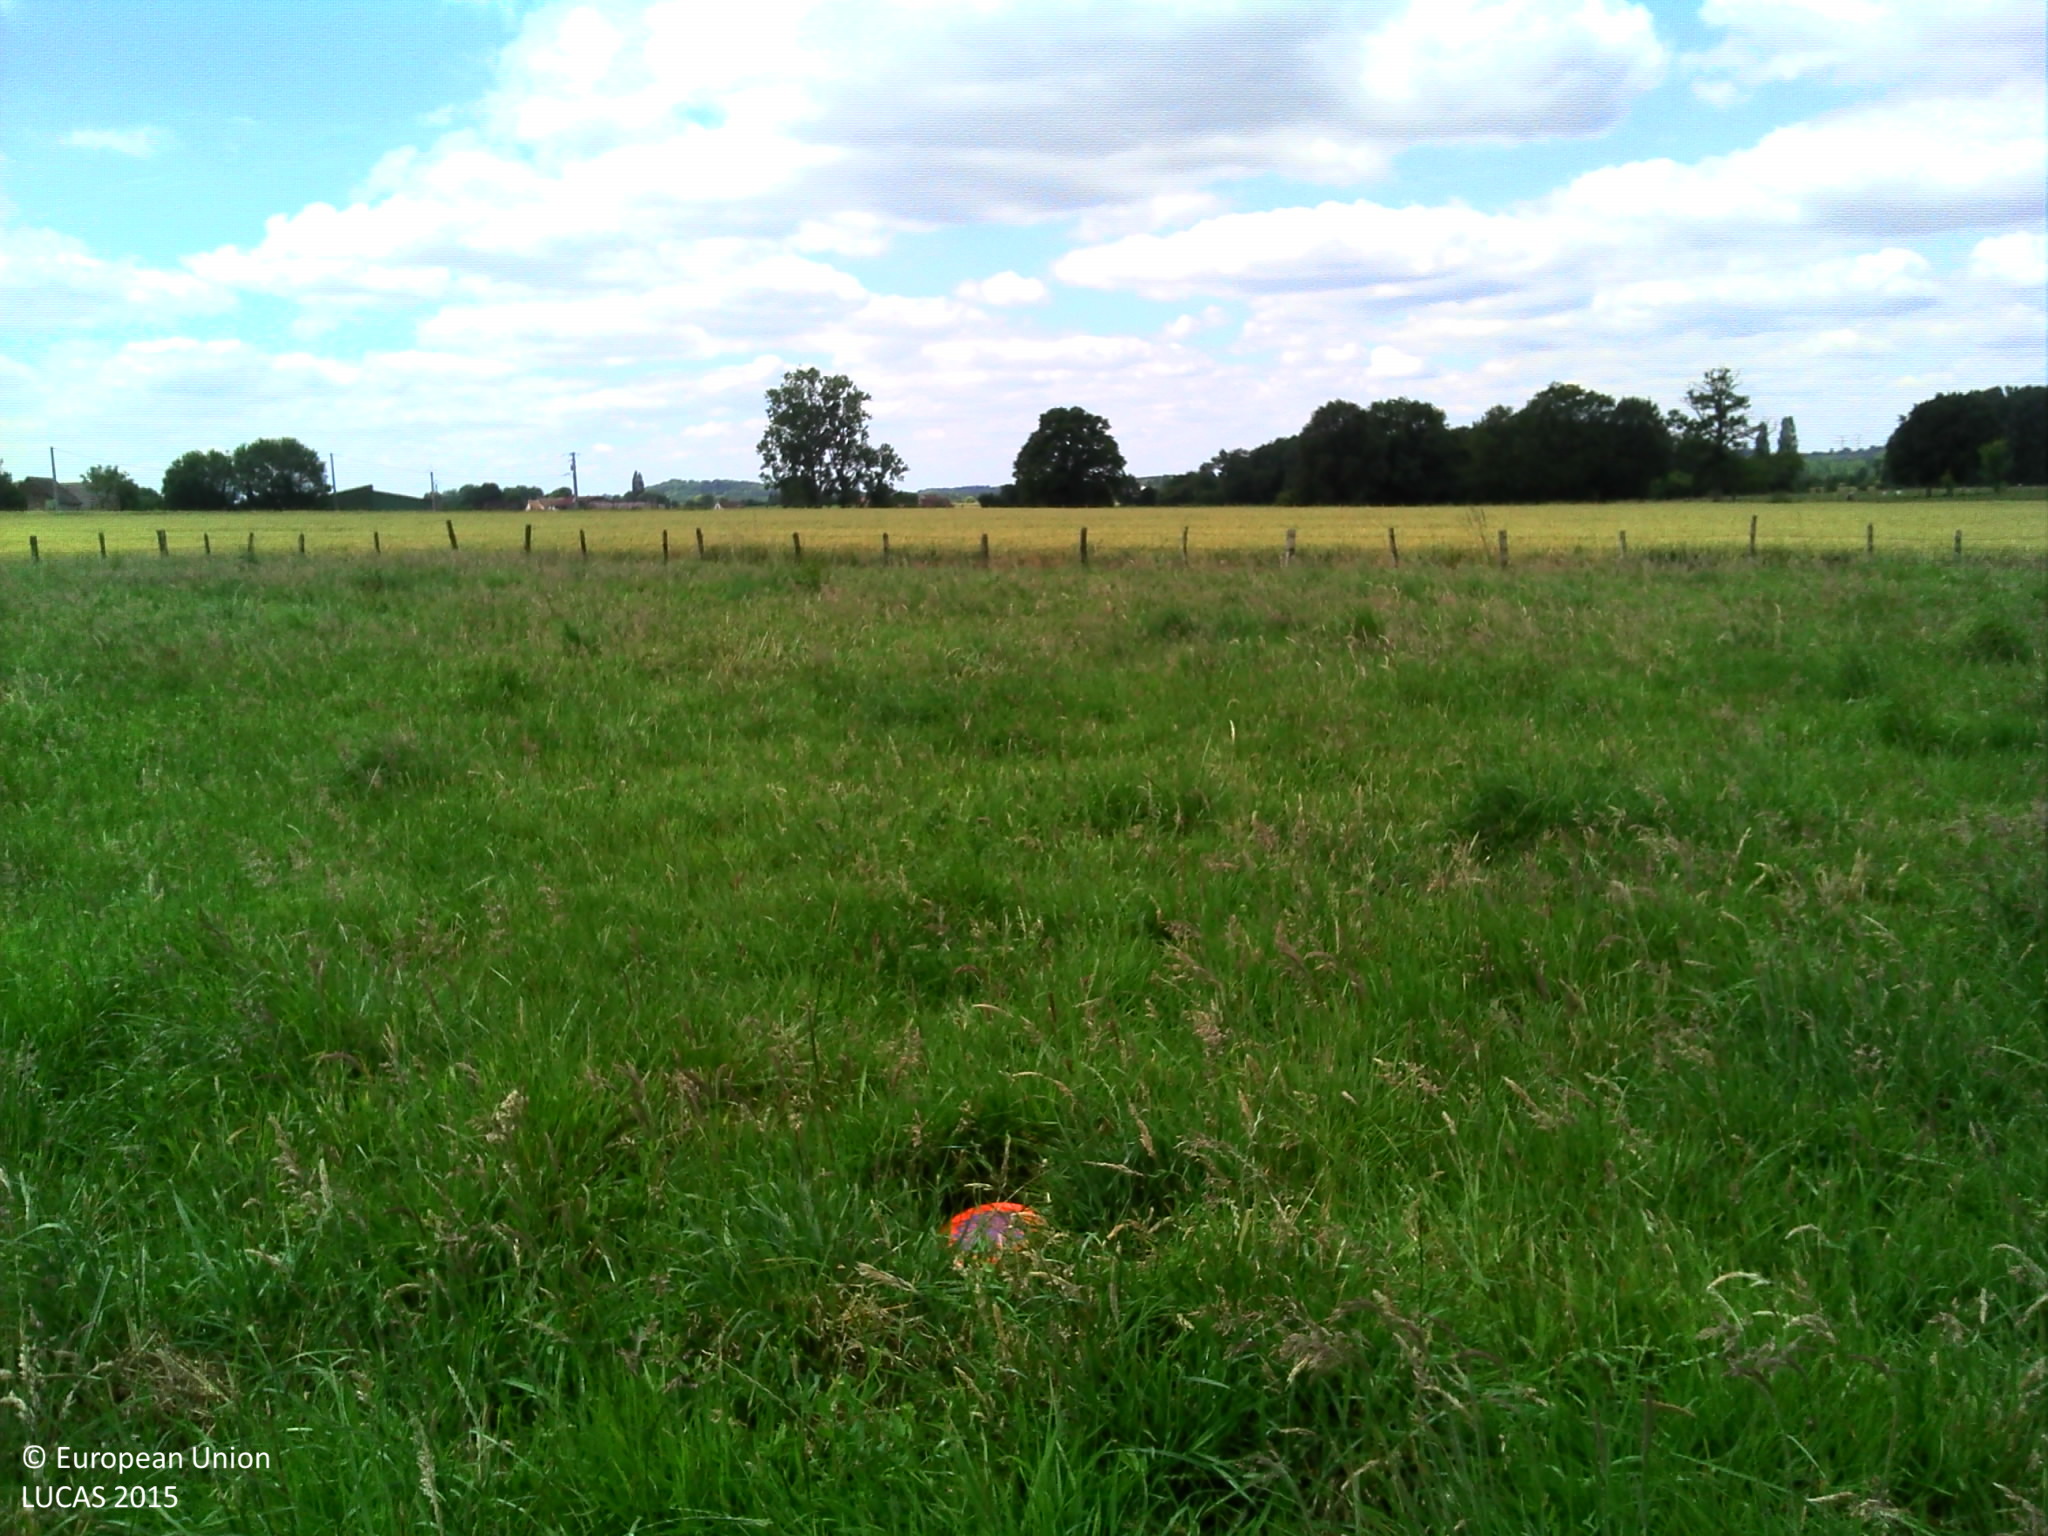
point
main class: Grassland
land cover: Grassland without tree/shrub cover
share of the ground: > 75 %
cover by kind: herbaceous plants 100 %
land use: Agriculture (excluding fallow land and kitchen gardens)
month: June
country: FR
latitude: 47.8433
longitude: 0.2338
